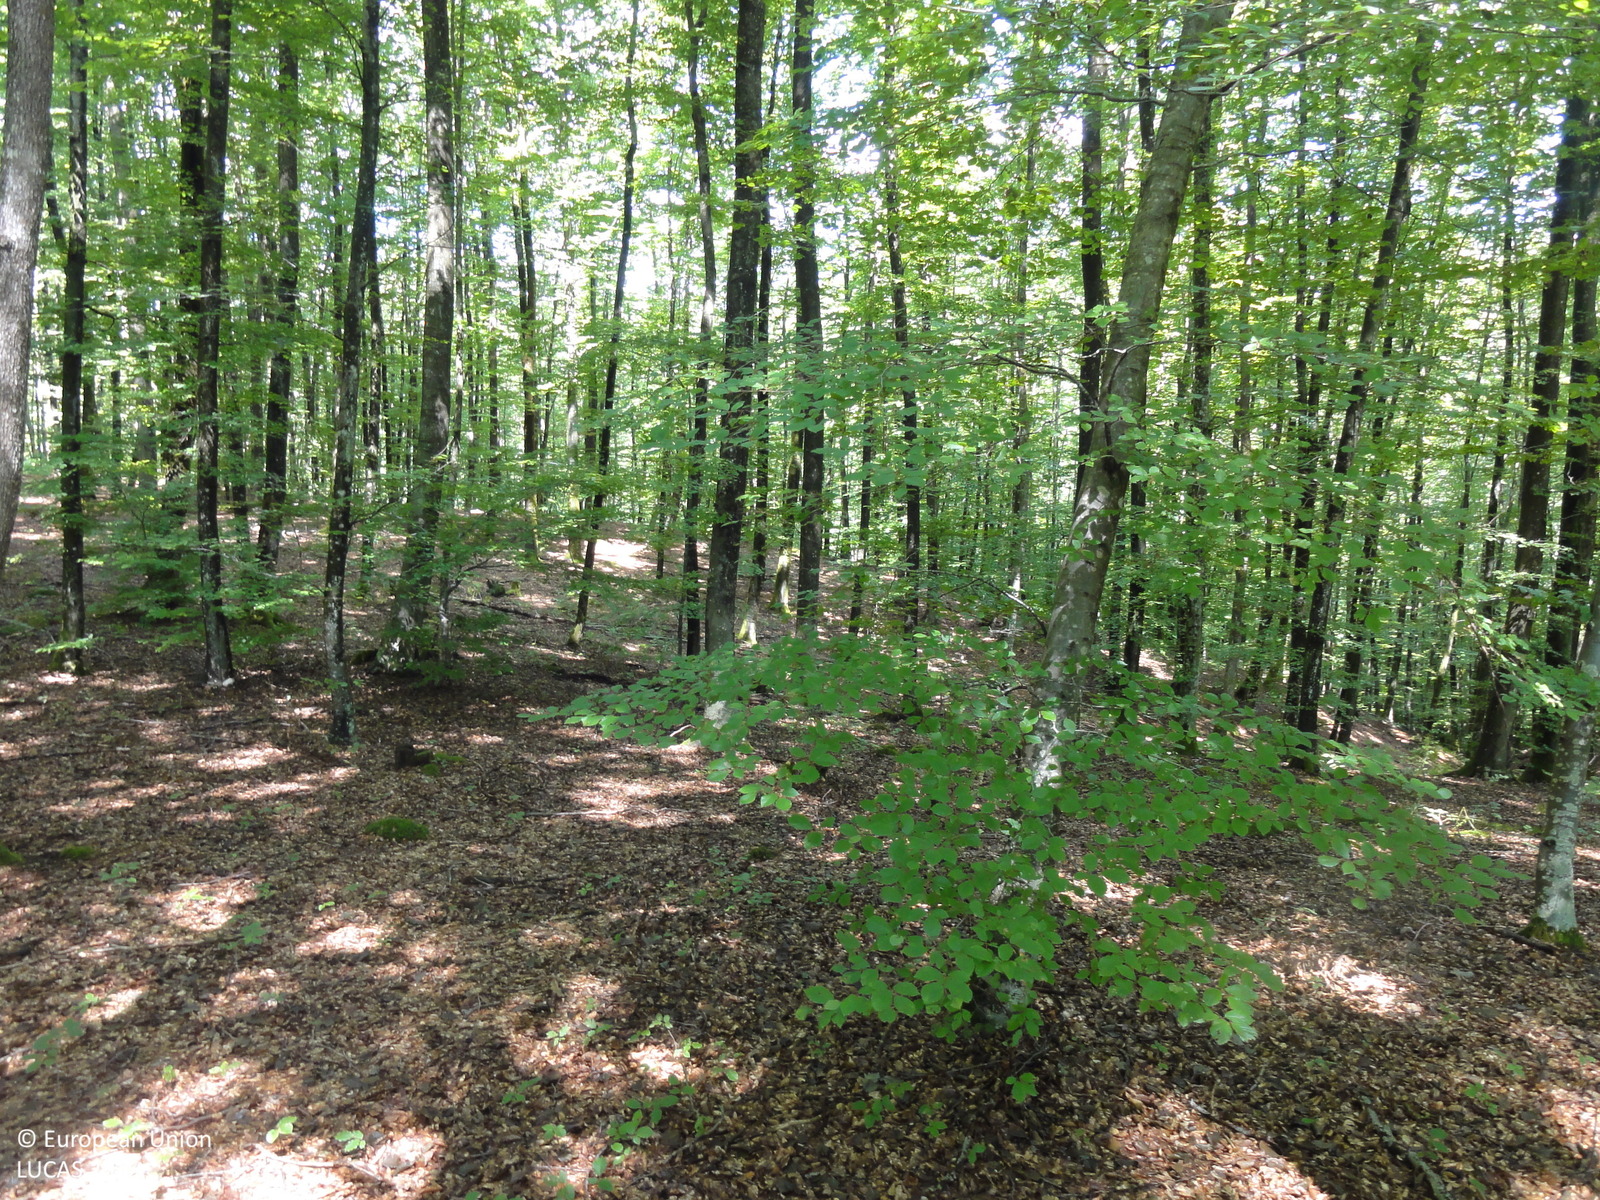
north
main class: Woodland
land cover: Broadleaved woodland
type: beech forest
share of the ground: > 75 %
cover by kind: broadleaved forest trees 100 %
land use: Forestry
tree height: > 5 m
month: August
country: SI
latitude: 46.0068
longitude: 15.2273
